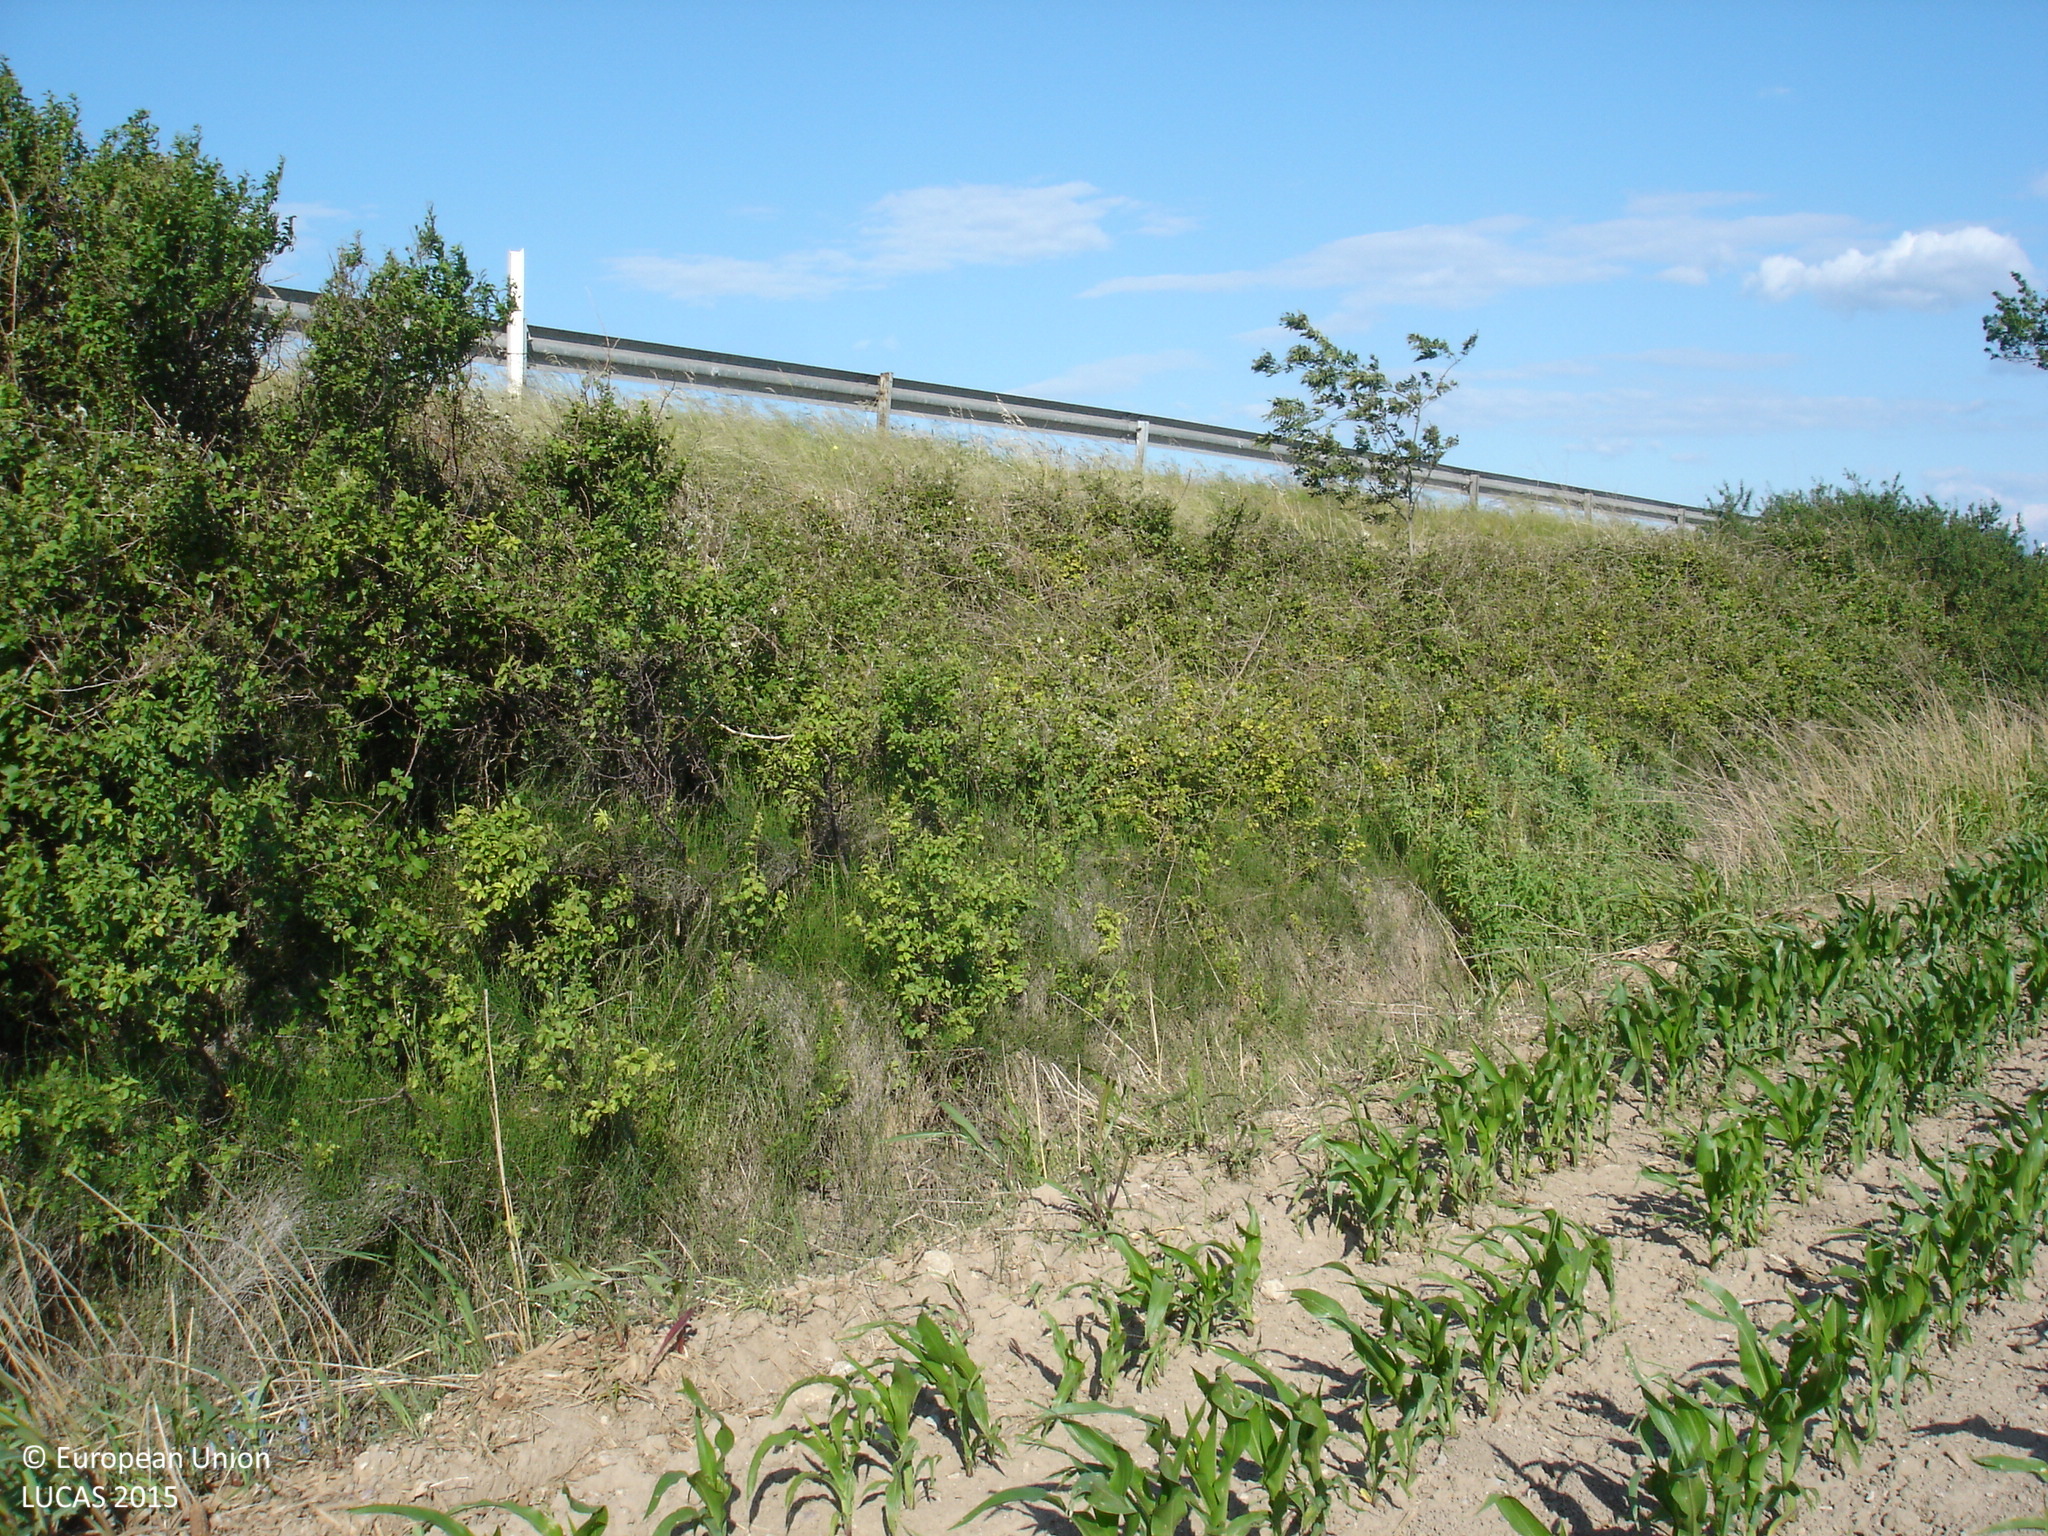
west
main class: Cropland
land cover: Maize
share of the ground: 25 - 50 %
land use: Agriculture (excluding fallow land and kitchen gardens)
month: May
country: ES
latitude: 42.2826
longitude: 2.9686
